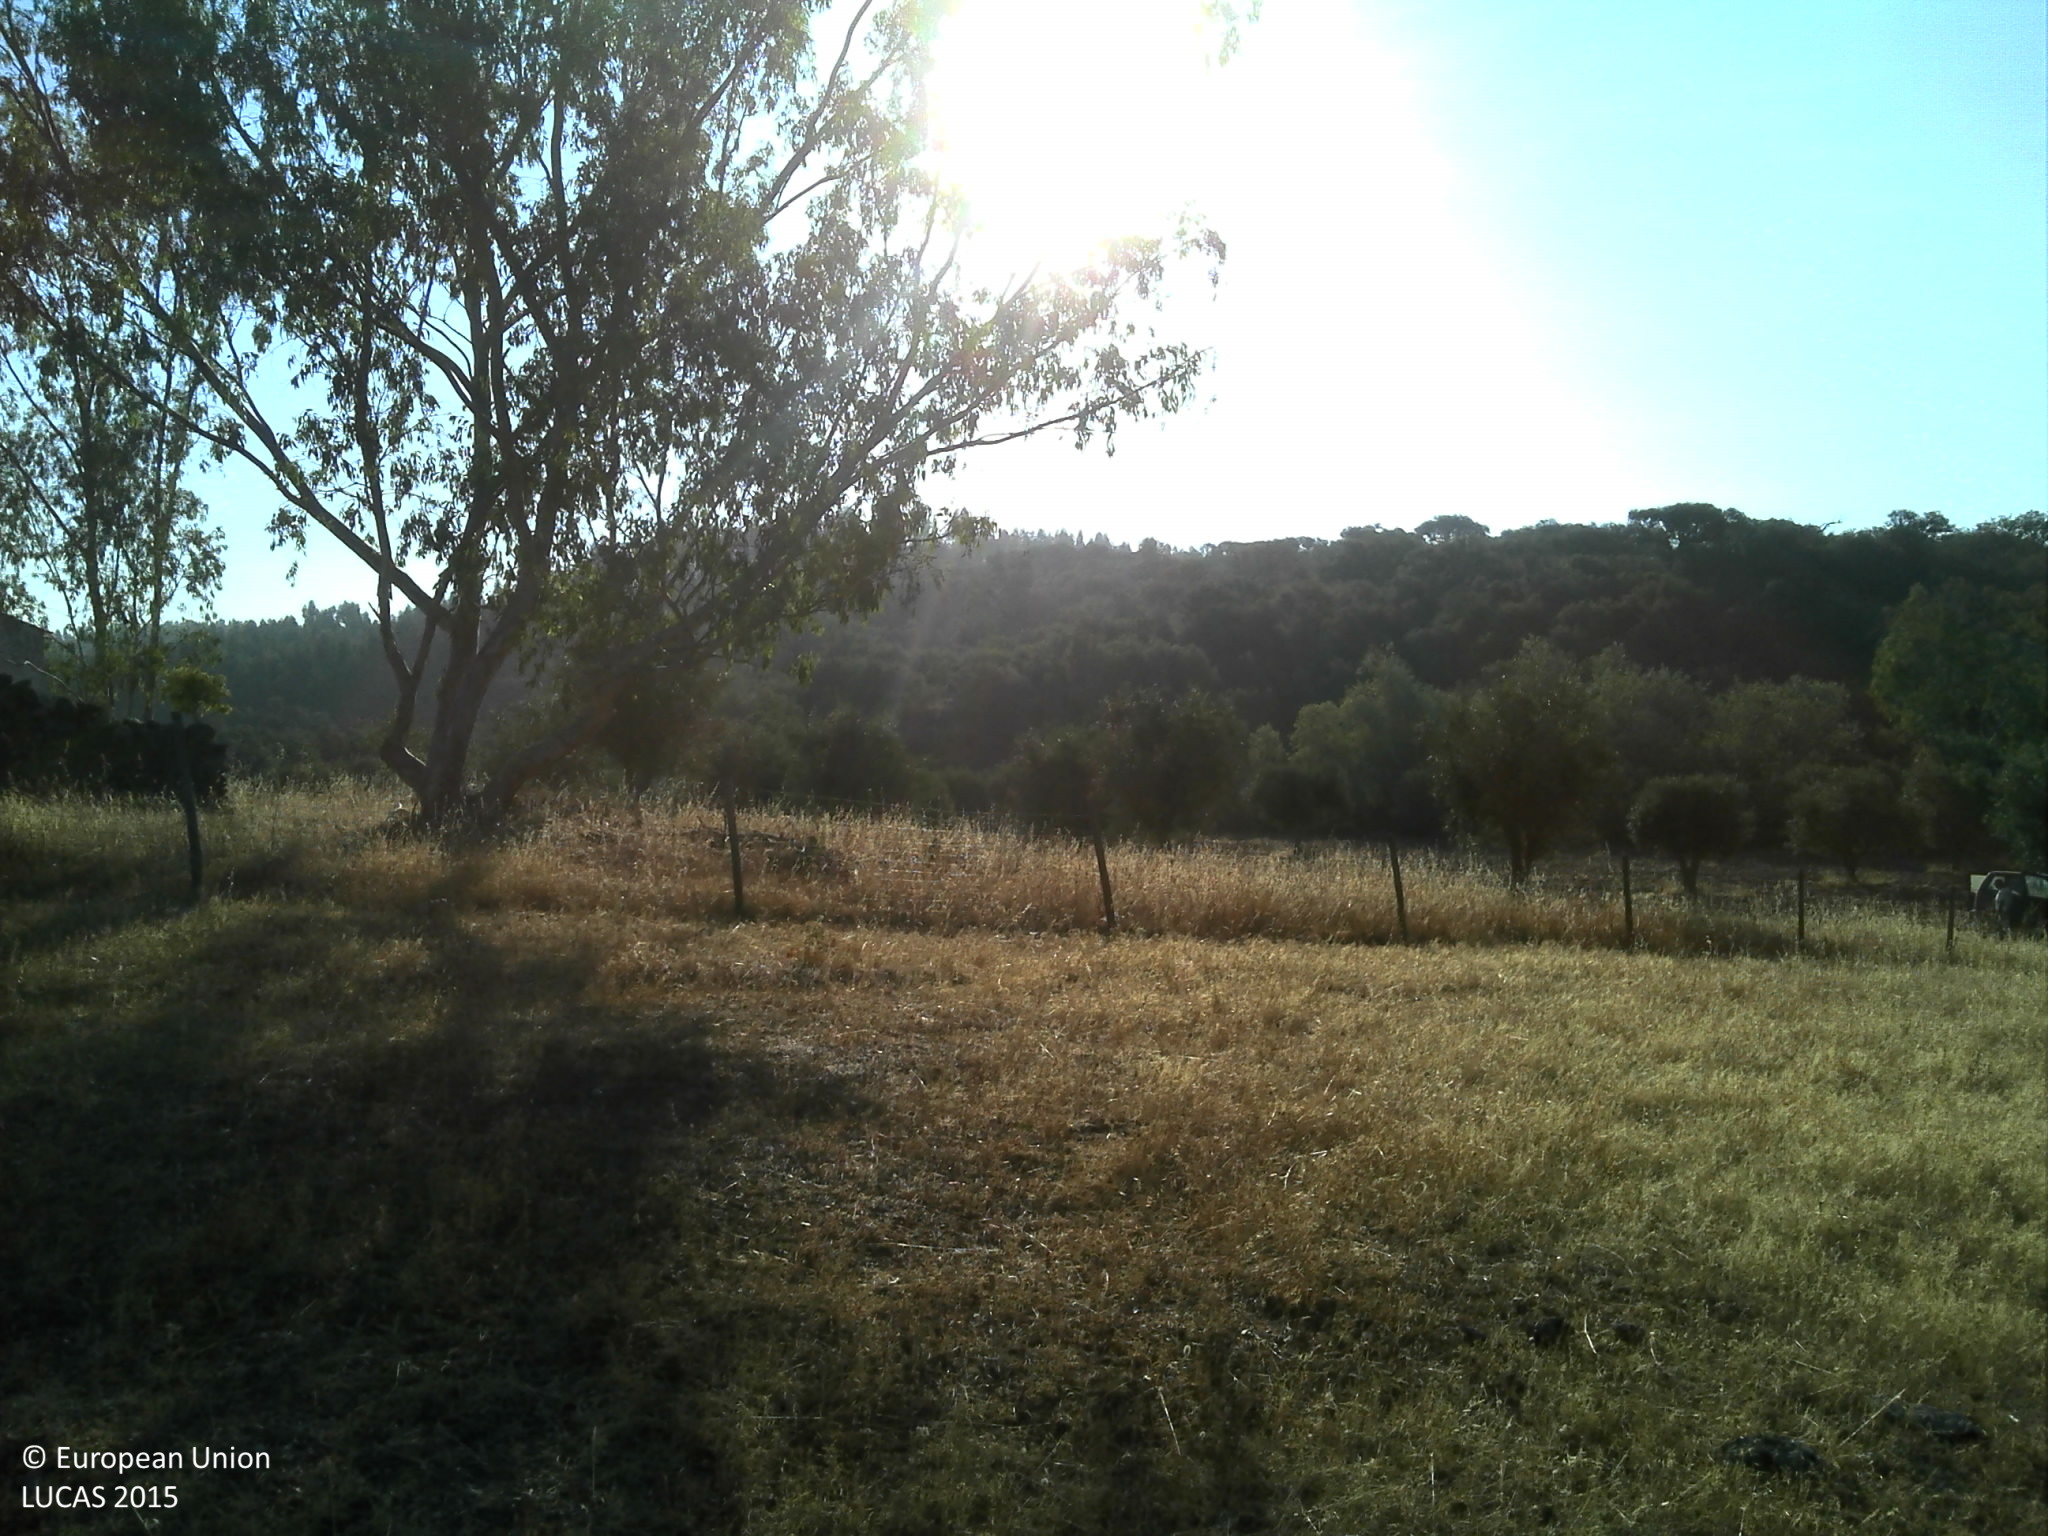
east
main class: Grassland
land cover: Grassland with sparse tree/shrub cover
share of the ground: 10 - 25 %
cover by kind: unconsolidated bare surface 65 %, herbaceous plants 25 %, broadleaved forest trees 5 %, shrubs 5 %
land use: Agriculture (excluding fallow land and kitchen gardens)
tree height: > 5 m
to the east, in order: Grassland with sparse tree/shrub cover; Fences; Olive groves; Tracks; Olive groves; Shruby margins; Inland fresh running water; Broadleaved woodland
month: July
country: PT
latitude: 38.5762
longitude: -7.4650
